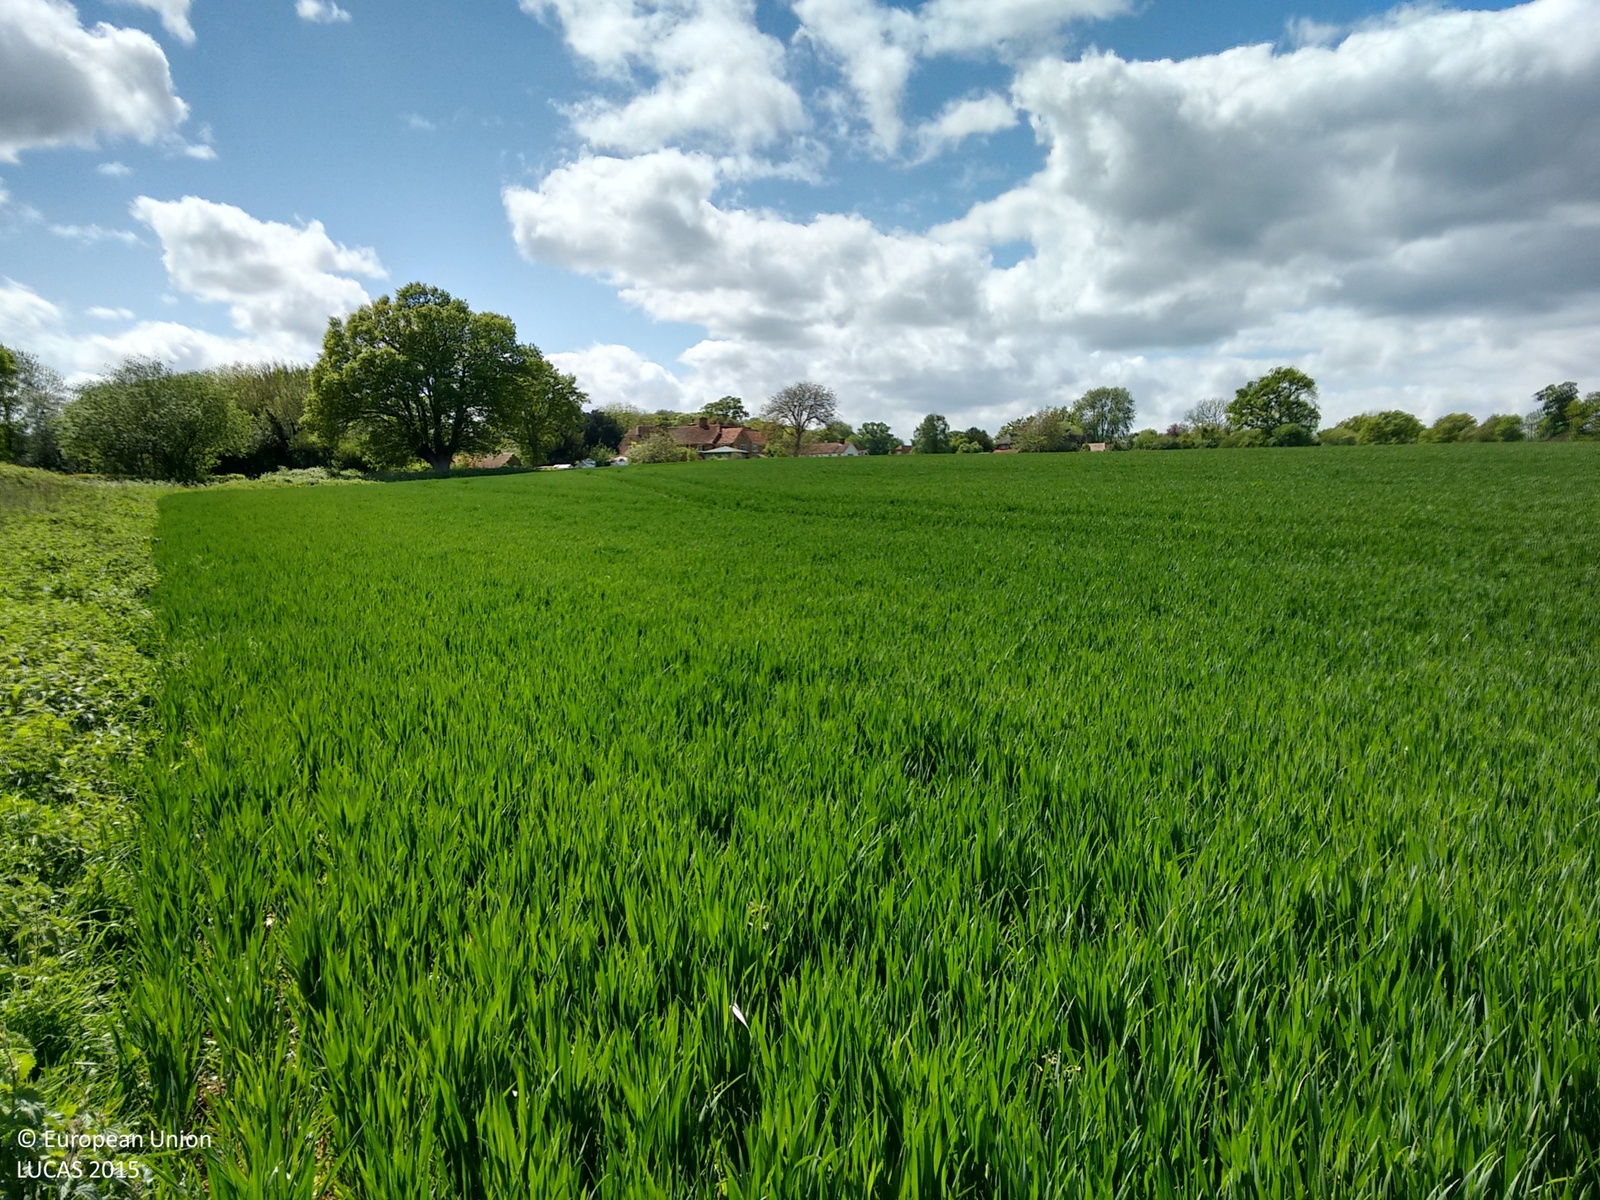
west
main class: Cropland
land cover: Common wheat
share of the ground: > 75 %
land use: Agriculture (excluding fallow land and kitchen gardens)
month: May
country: GB
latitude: 51.3194
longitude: -1.1960
